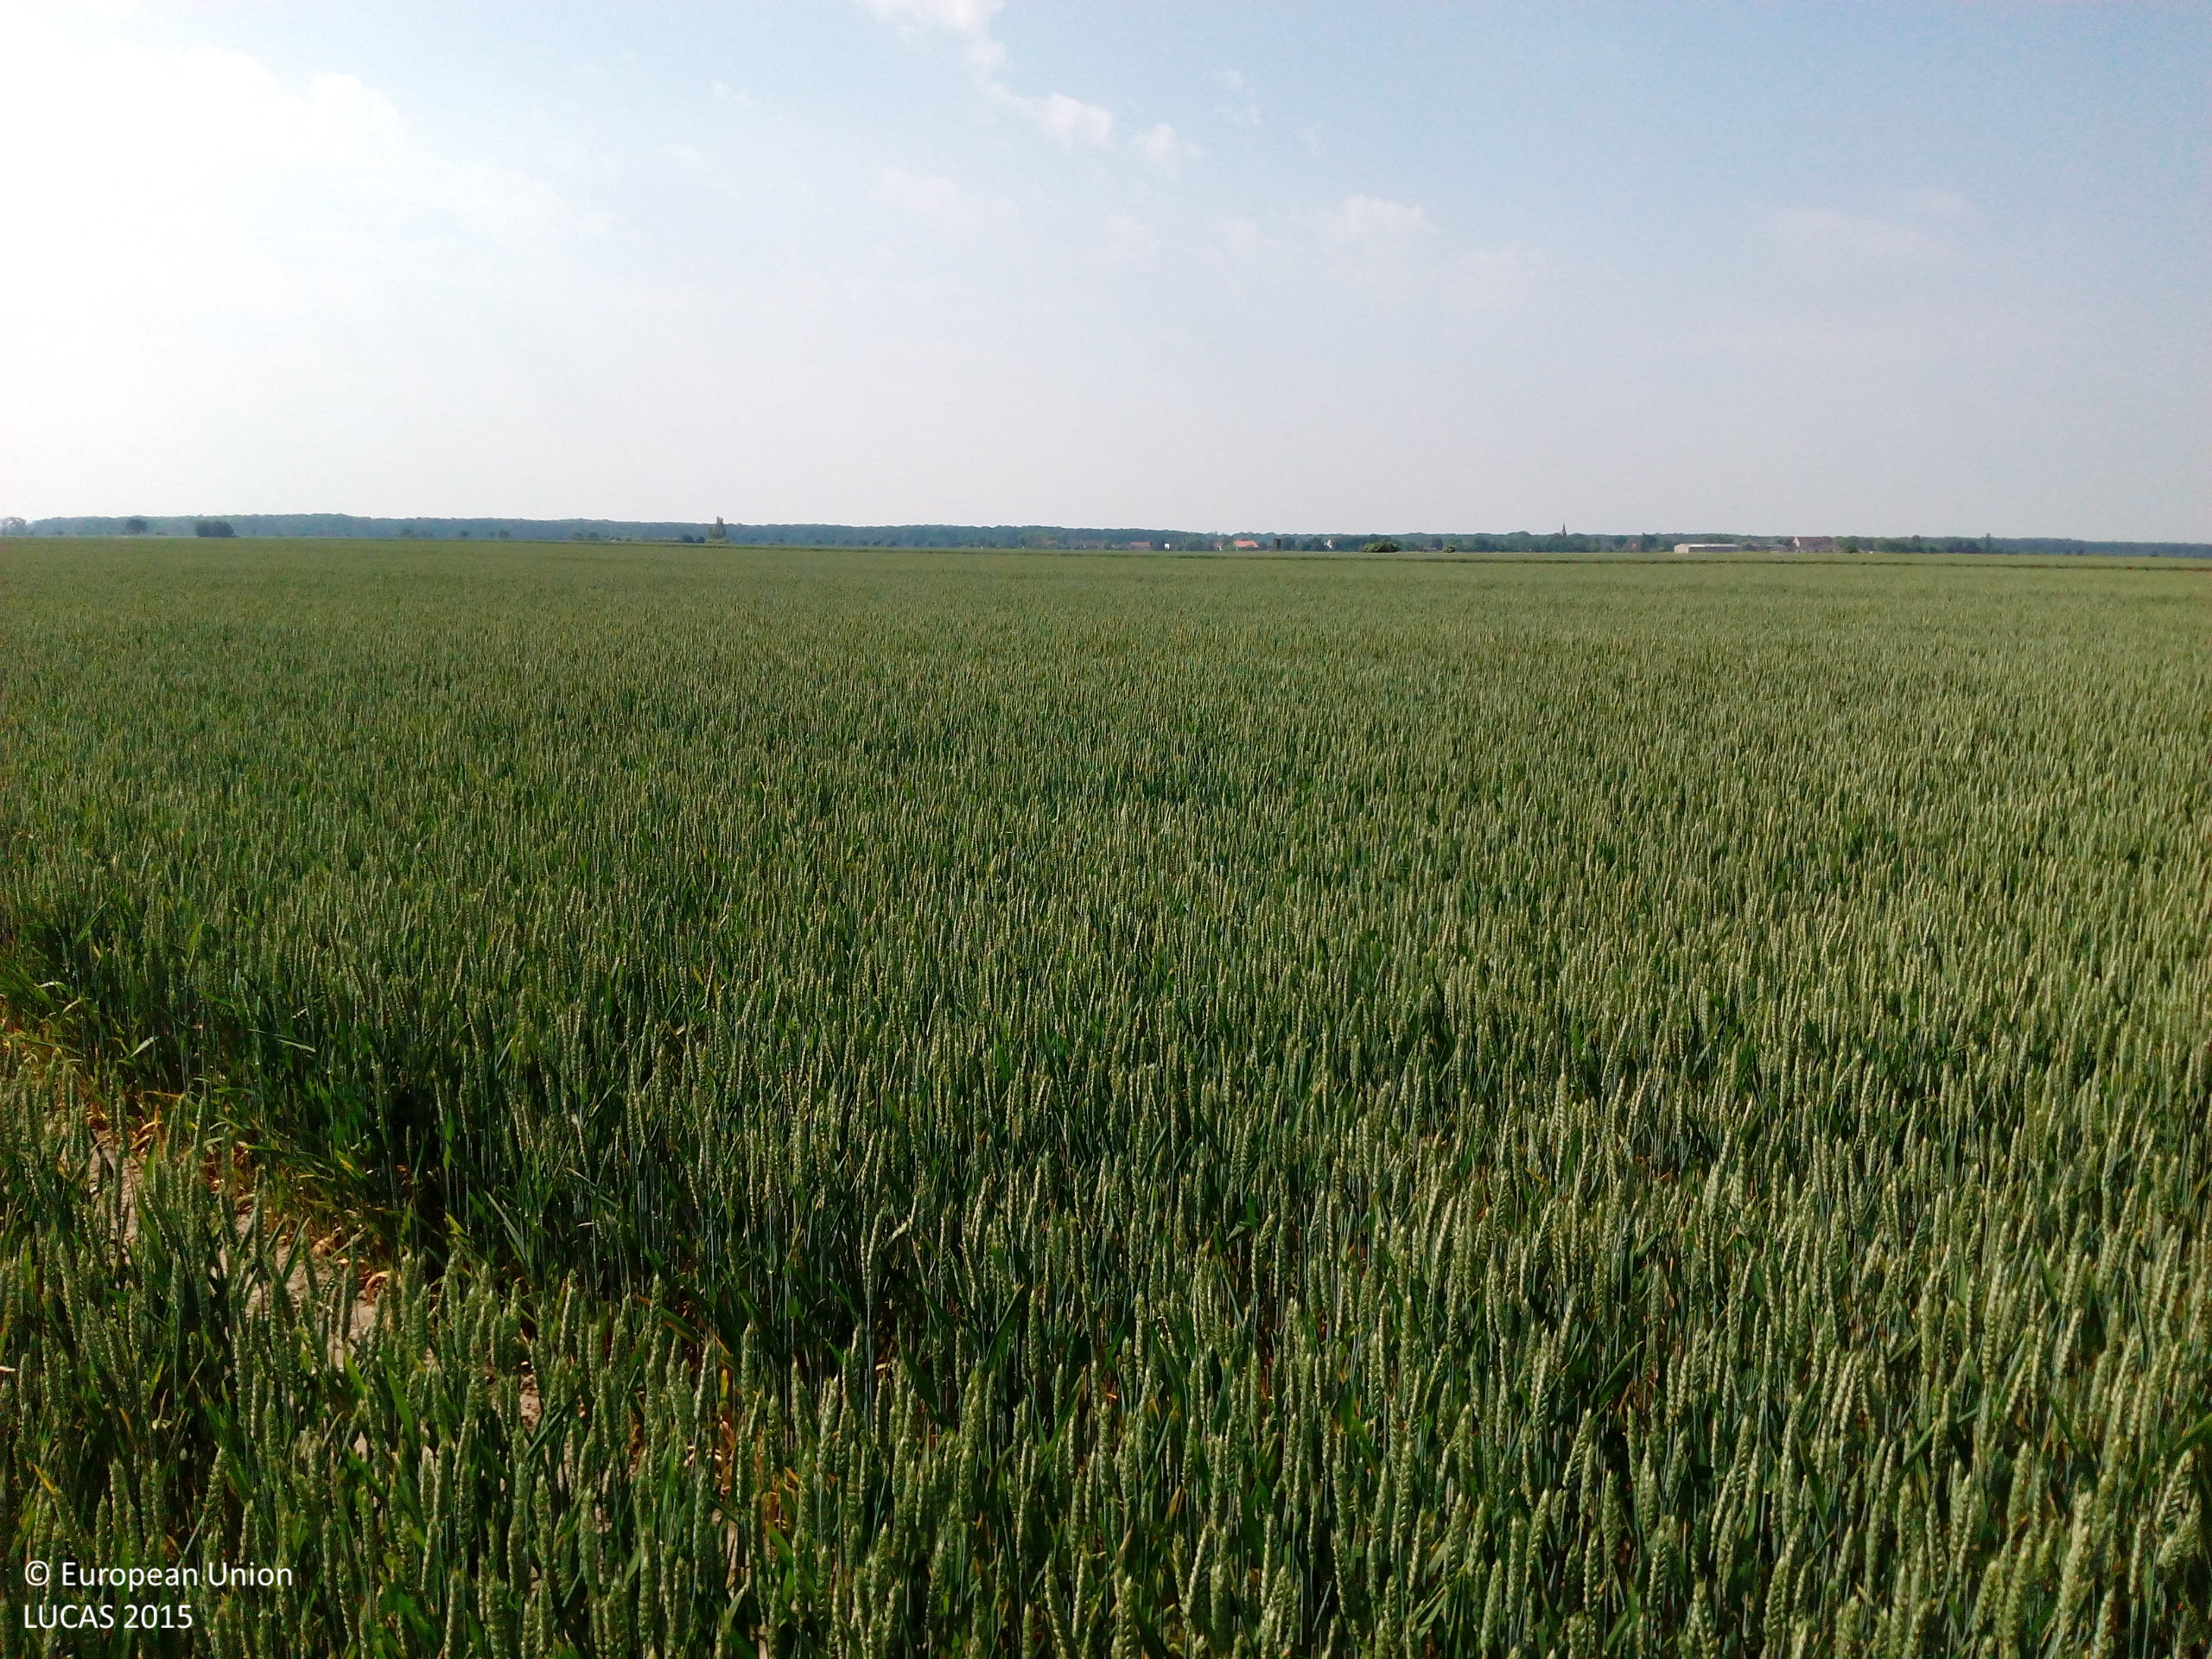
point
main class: Cropland
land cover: Common wheat
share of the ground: > 75 %
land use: Agriculture (excluding fallow land and kitchen gardens)
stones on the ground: 25 - 50 %
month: June
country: DE
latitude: 51.5049
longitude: 12.5498
